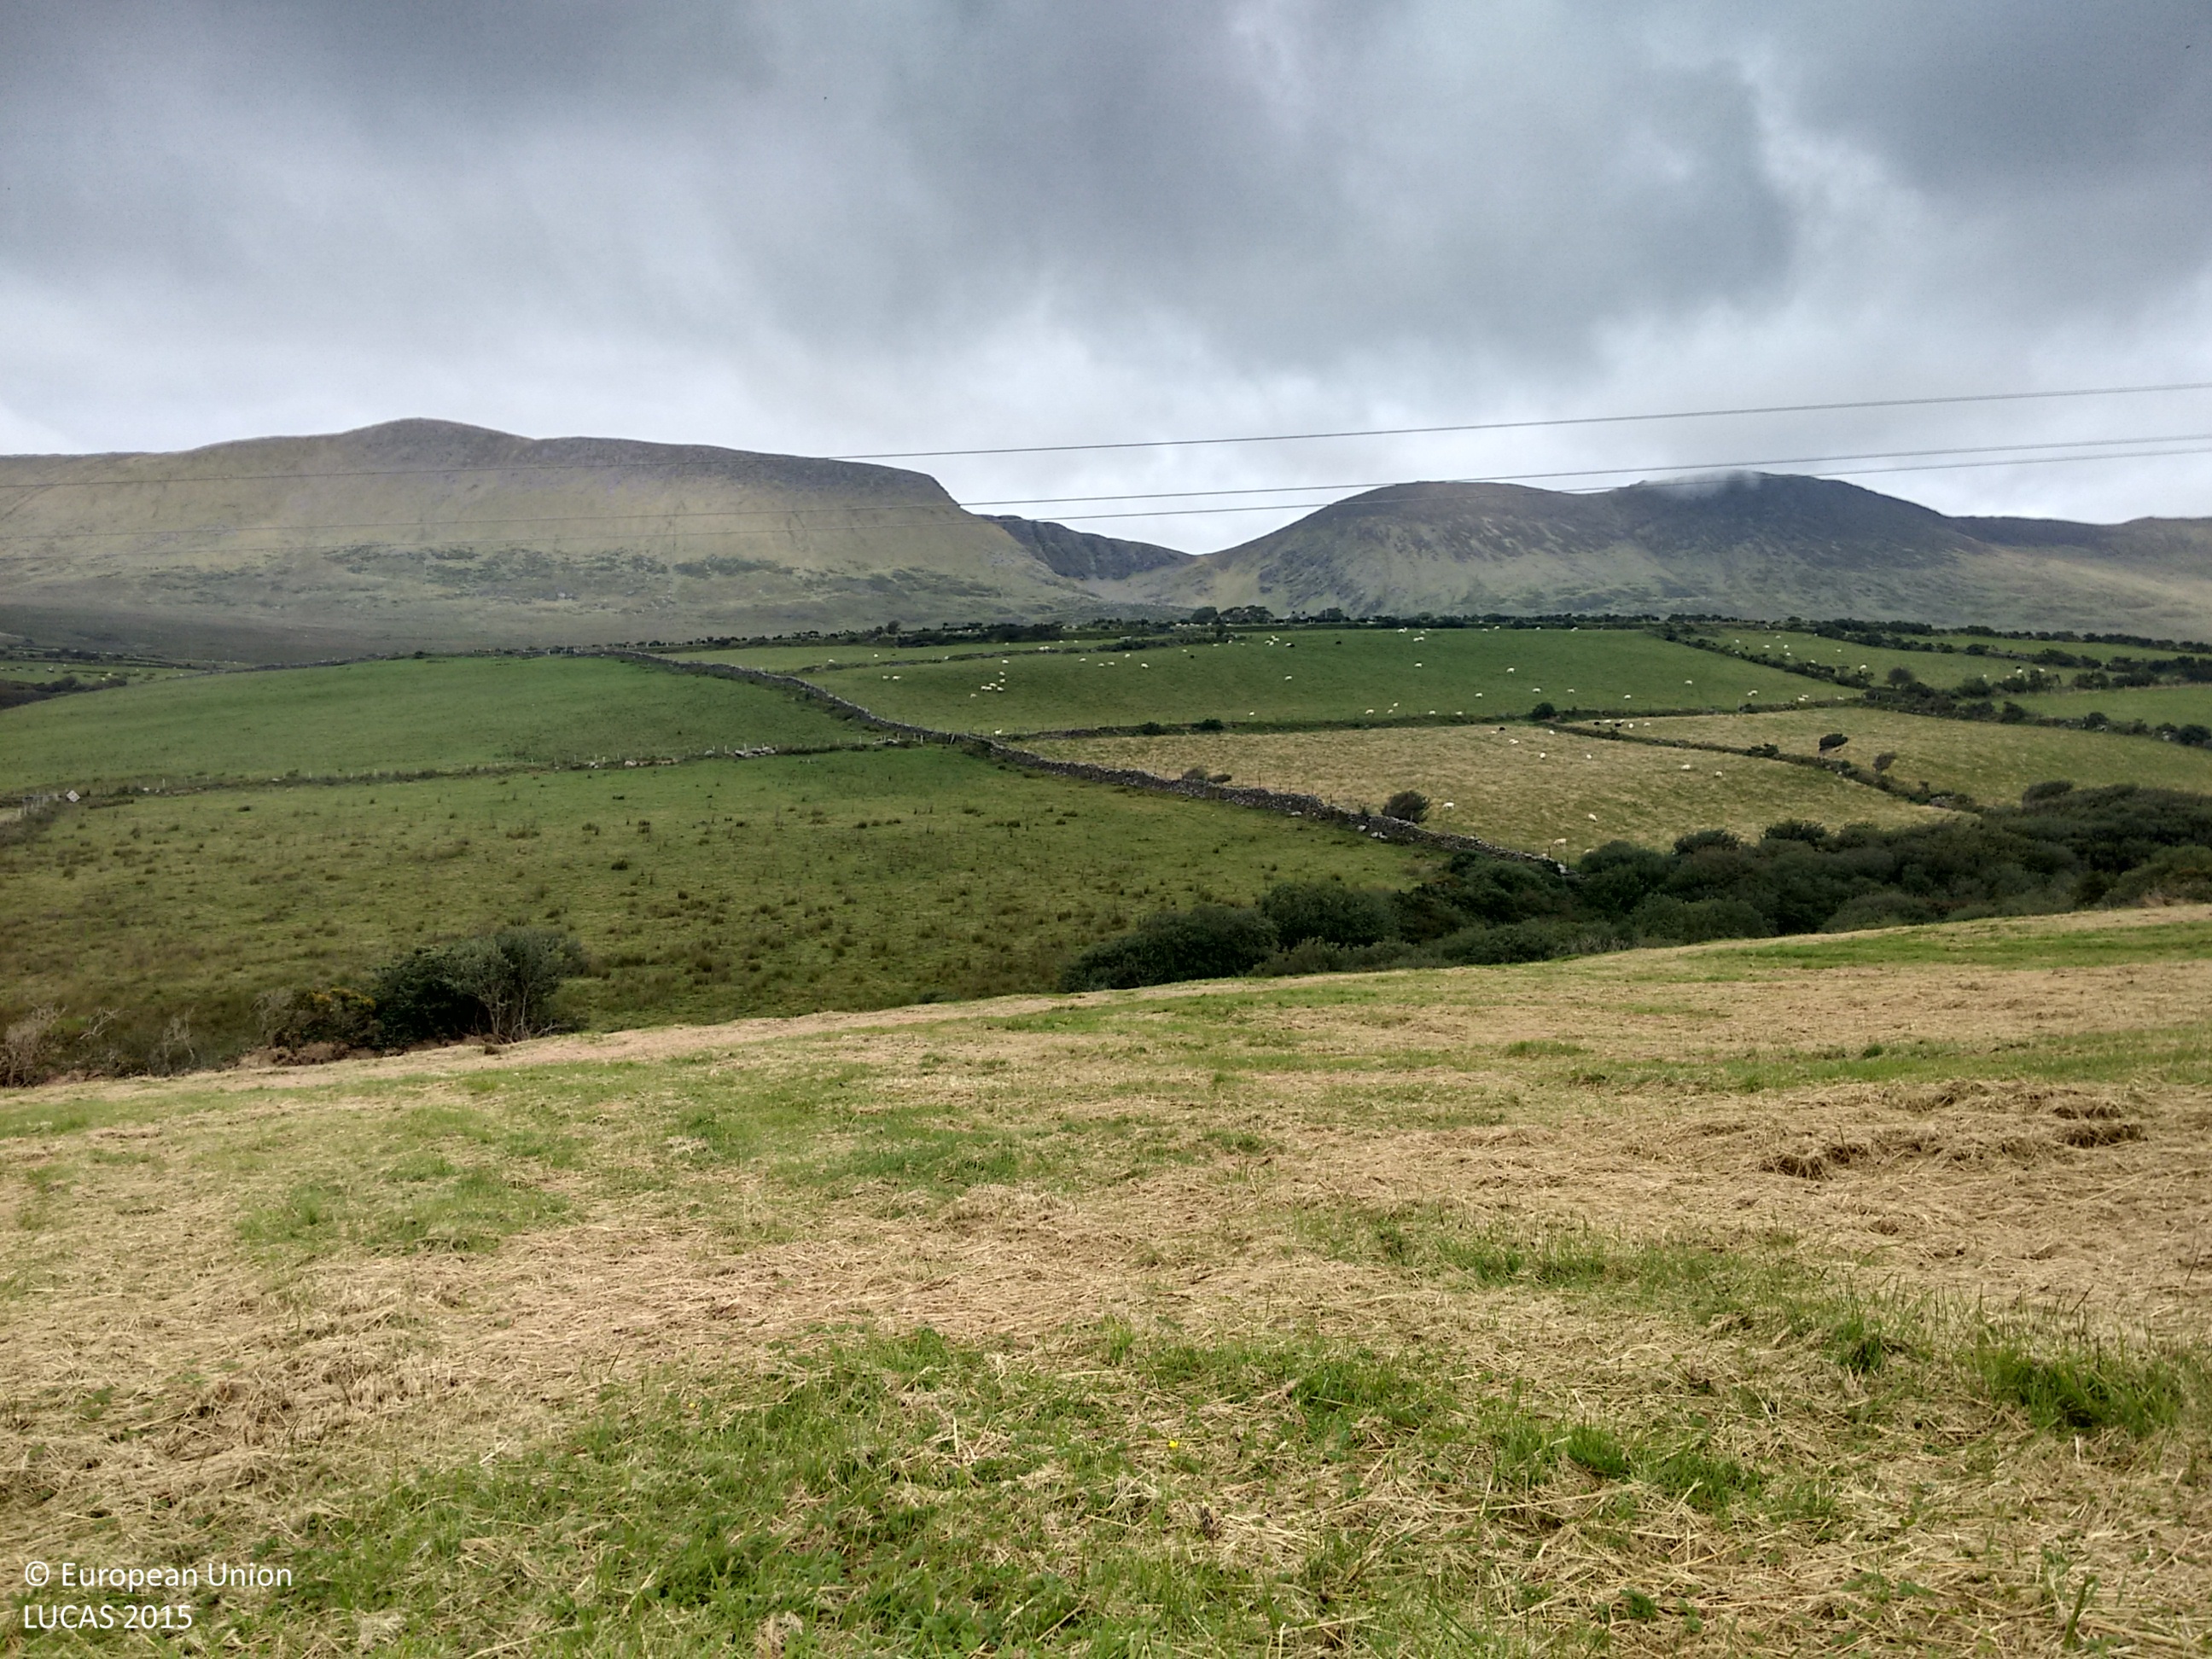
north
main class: Grassland
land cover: Grassland without tree/shrub cover
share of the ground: > 75 %
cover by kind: herbaceous plants 100 %
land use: Agriculture (excluding fallow land and kitchen gardens)
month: September
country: IE
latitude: 52.1449
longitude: -10.1491
